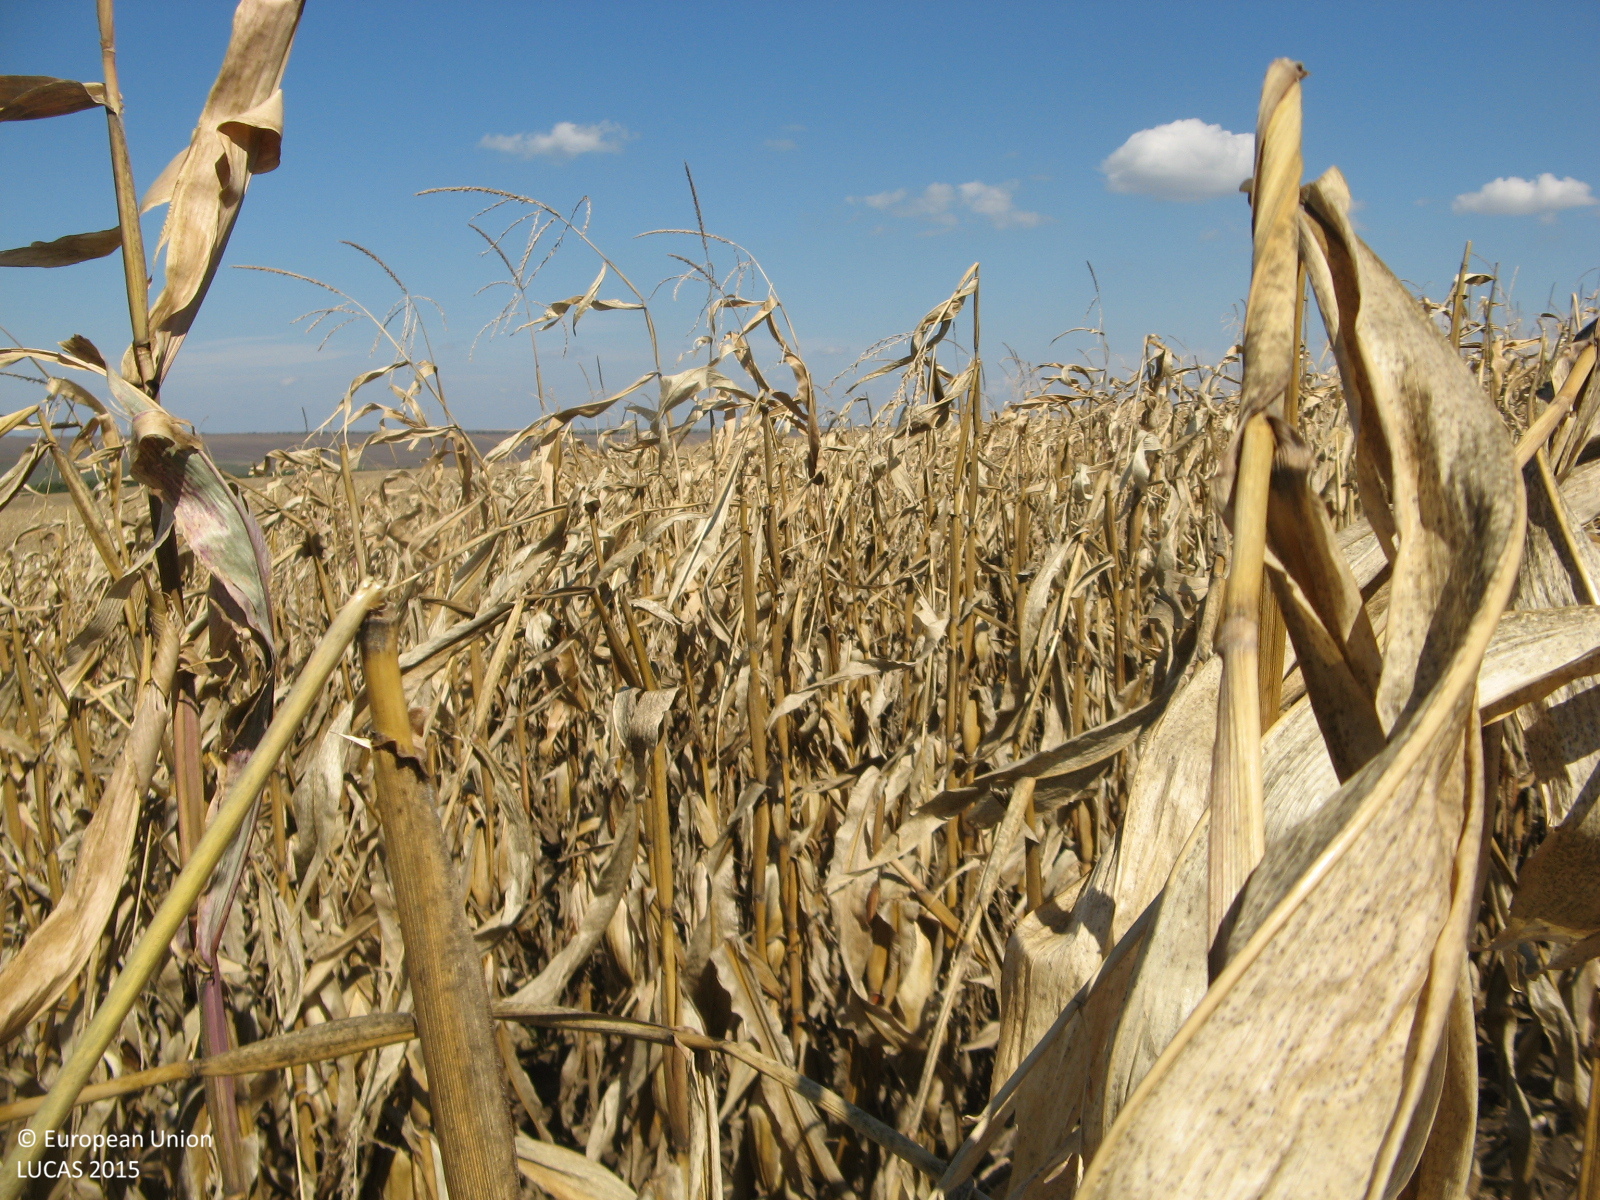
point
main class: Cropland
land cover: Maize
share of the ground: > 75 %
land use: Agriculture (excluding fallow land and kitchen gardens)
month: September
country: BG
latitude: 43.5252
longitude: 25.3843
